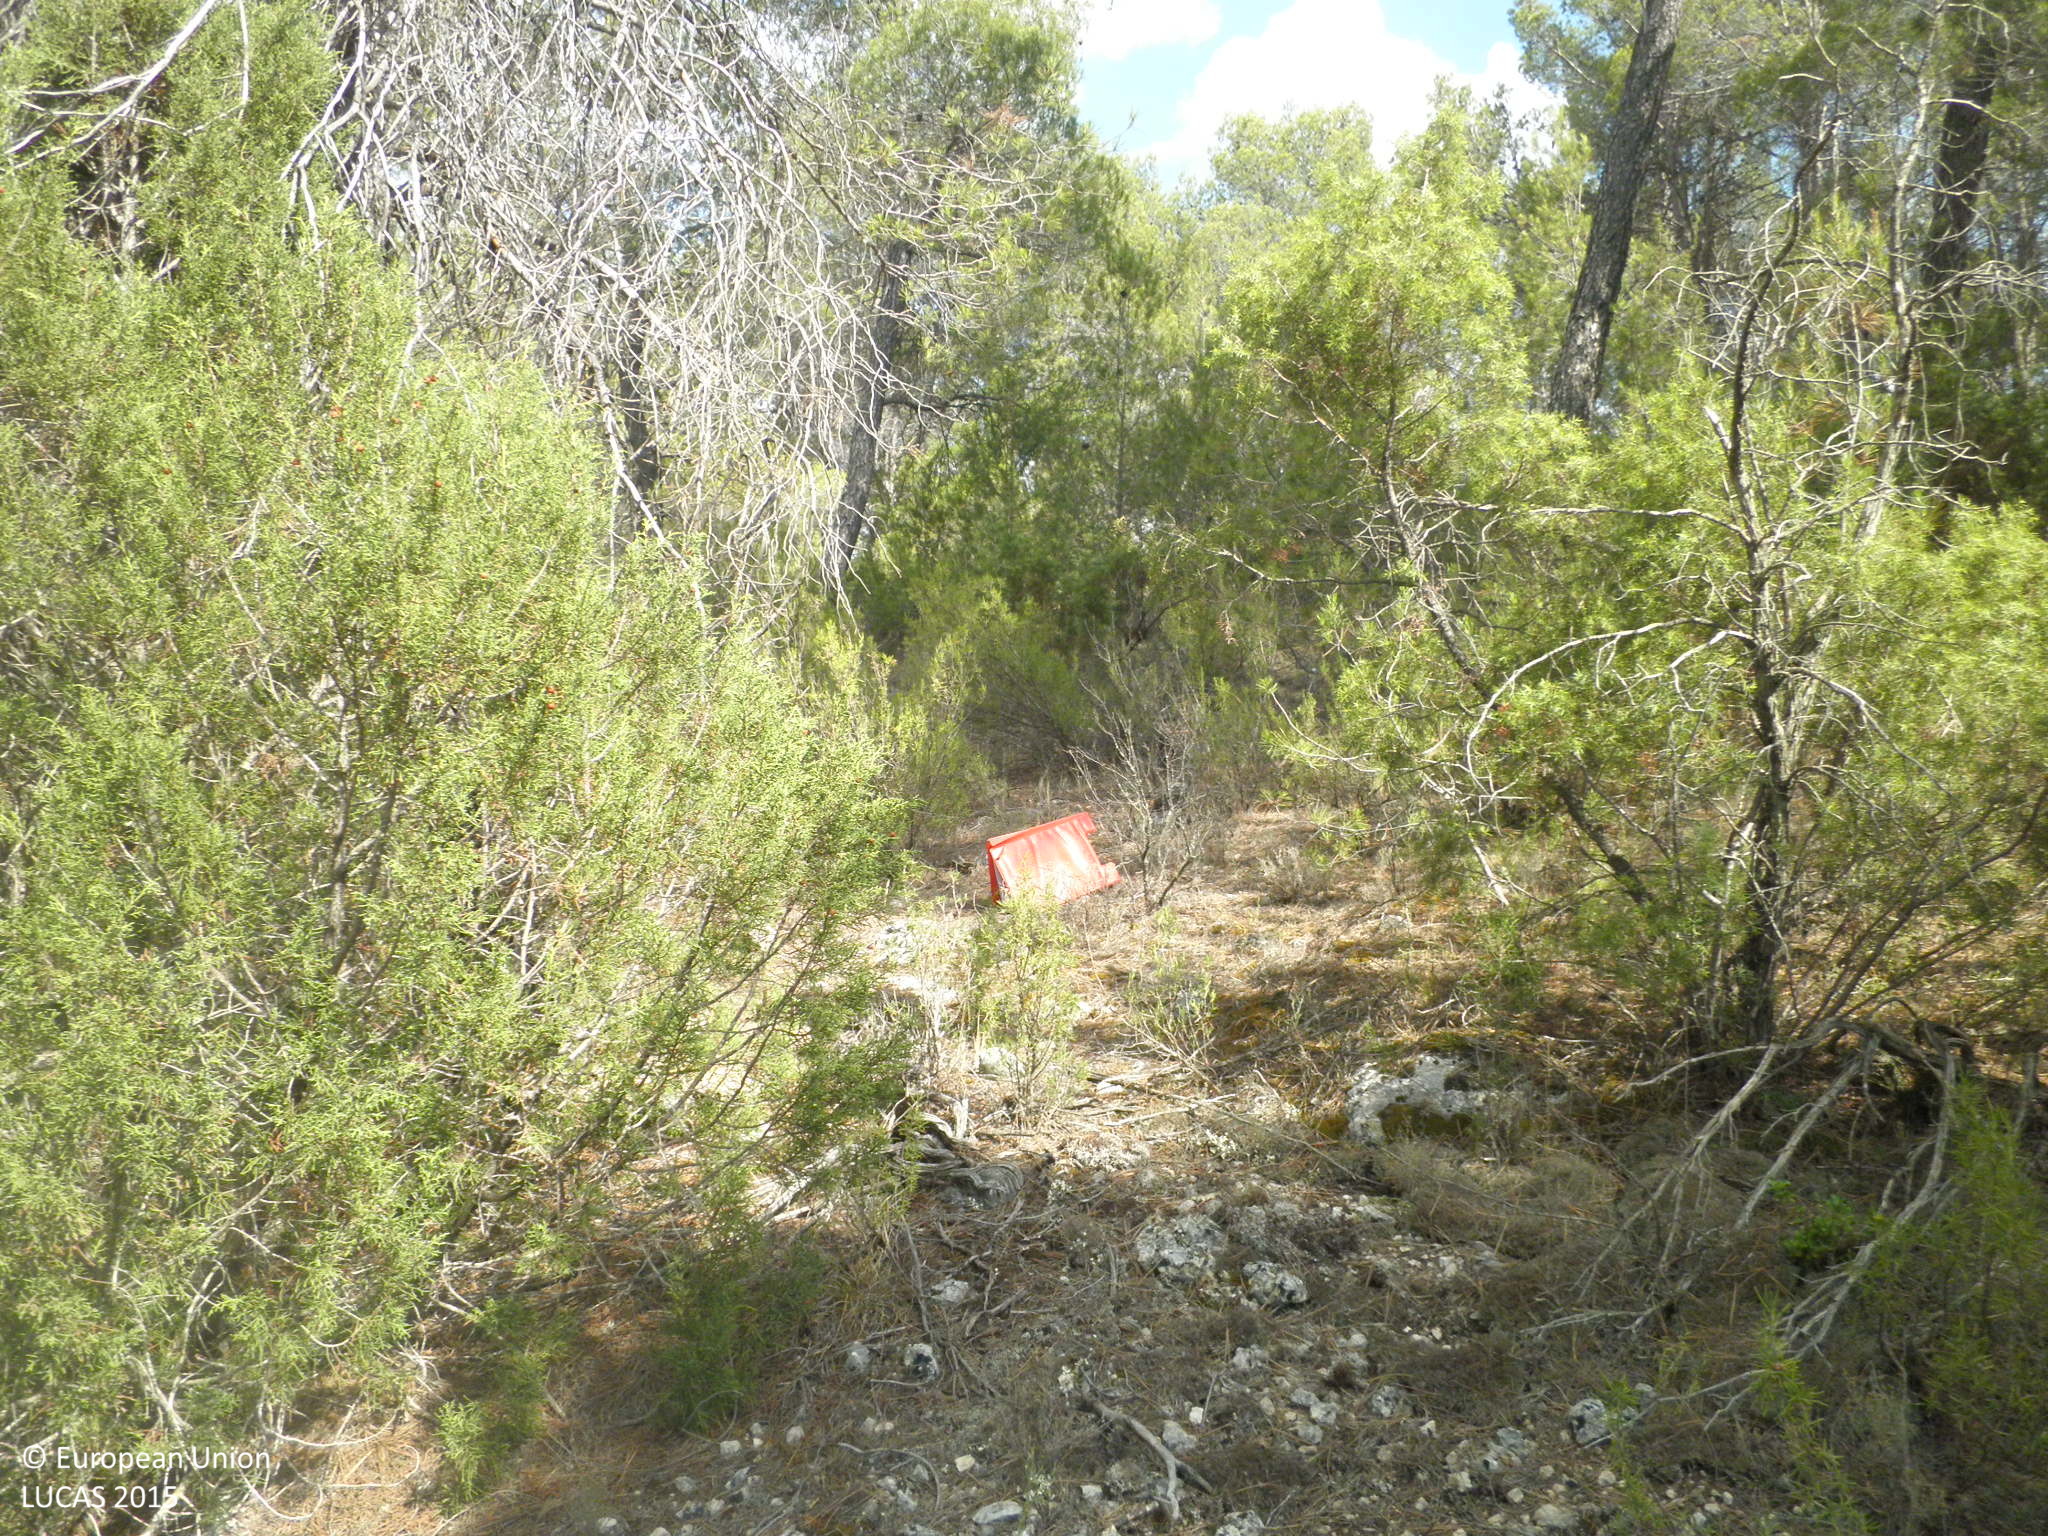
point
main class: Woodland
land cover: Pine dominated coniferous woodland
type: coniferous forest of the mediterranean region
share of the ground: 50 - 75 %
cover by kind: coniferous forest trees 50 %, shrubs 30 %, herbaceous plants 10 %, unconsolidated bare surface 10 %
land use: Semi-natural and natural areas not in use
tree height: > 5 m
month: July
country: ES
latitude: 39.6289
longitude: -1.6219
